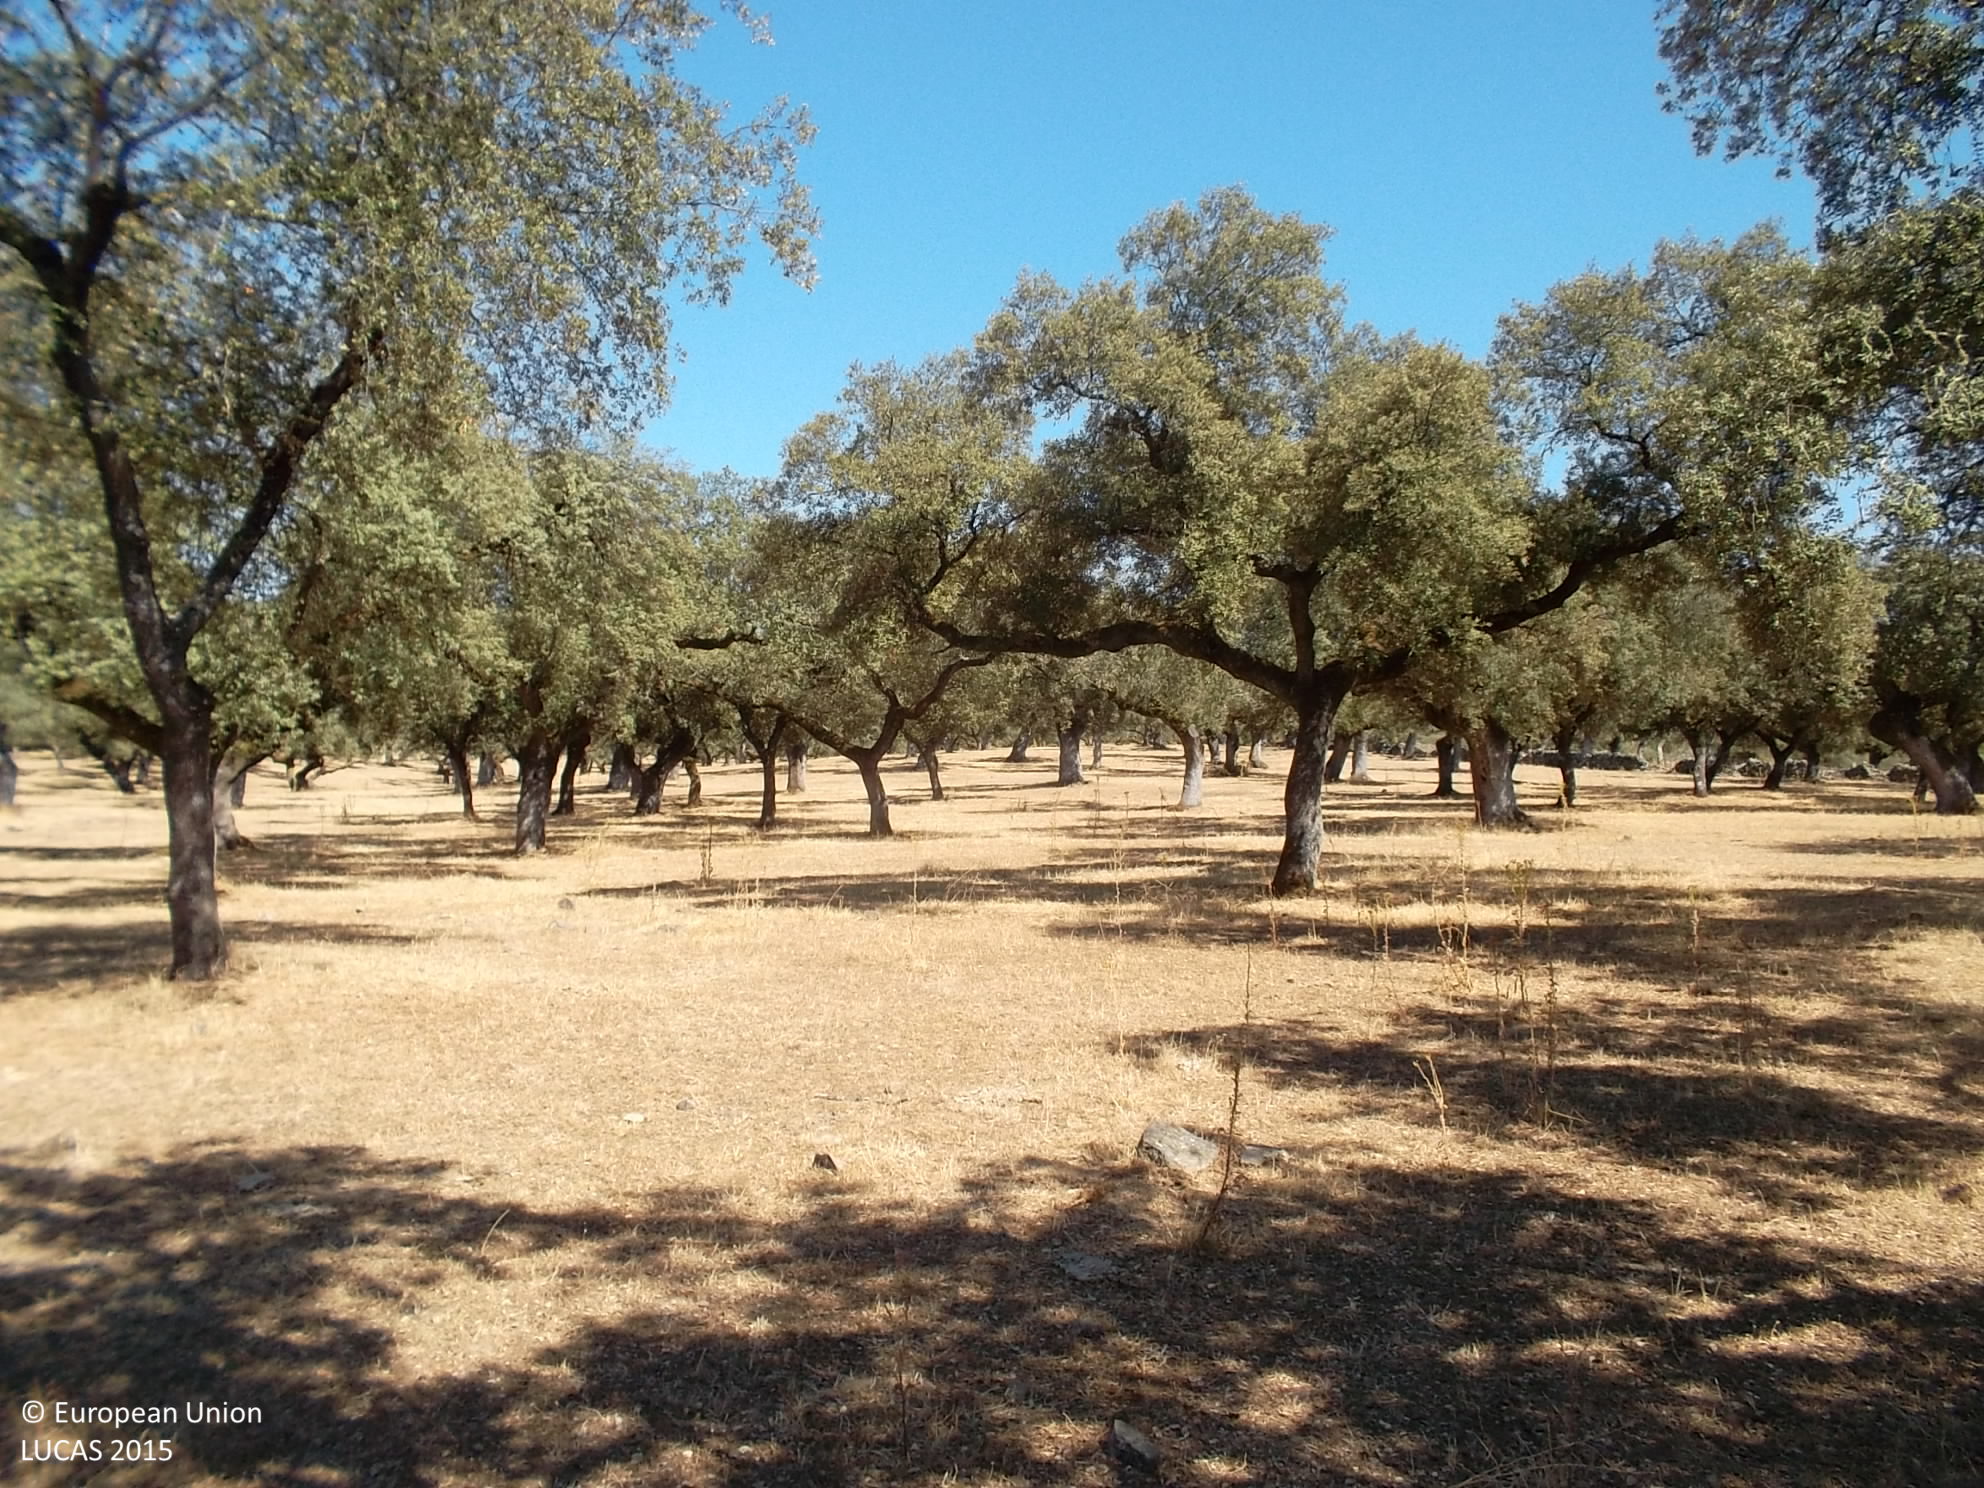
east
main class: Woodland
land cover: Broadleaved woodland
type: broadleaved evergreen forest
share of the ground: 50 - 75 %
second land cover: Grassland without tree/shrub cover
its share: 50 - 75 %
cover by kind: broadleaved forest trees 50 %, herbaceous plants 50 %
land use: Forestry
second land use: Agriculture (excluding fallow land and kitchen gardens)
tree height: > 5 m
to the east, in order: Broadleaved woodland; Grassland without tree/shrub cover
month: August
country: ES
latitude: 38.4193
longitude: -6.6978
